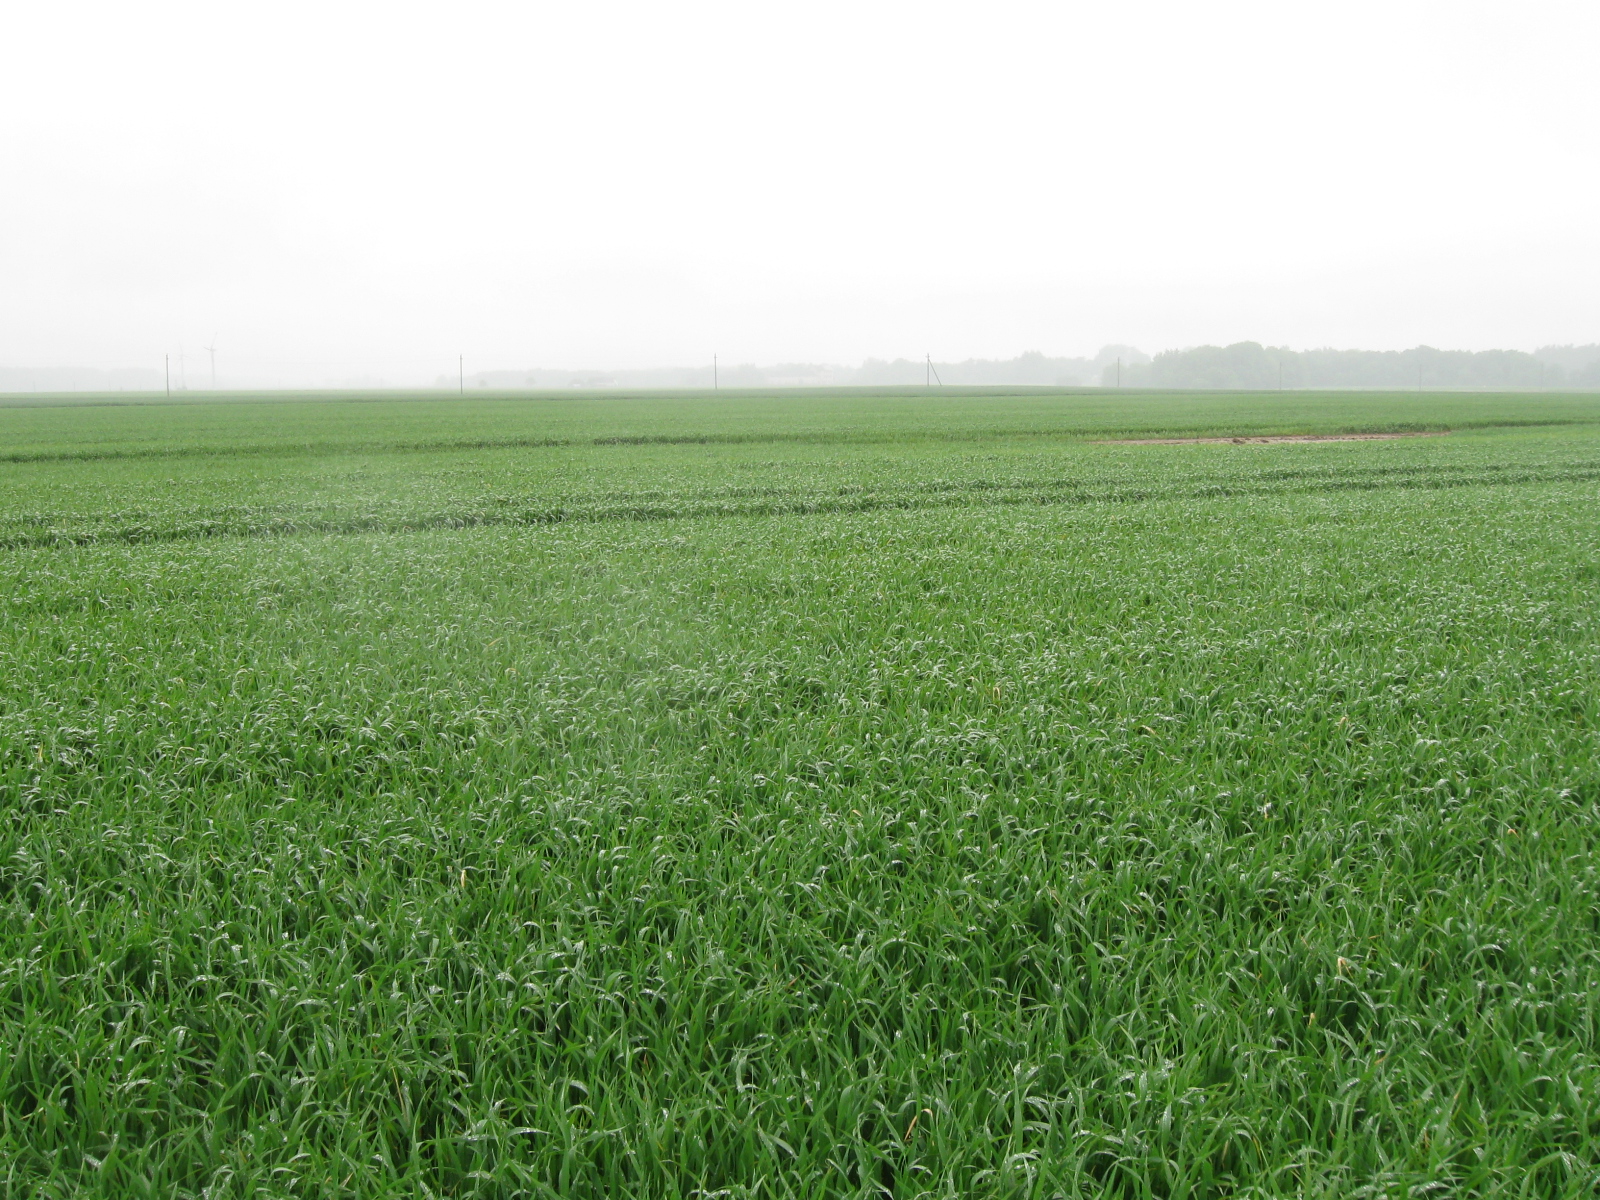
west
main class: Cropland
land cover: Common wheat
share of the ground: > 75 %
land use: Agriculture (excluding fallow land and kitchen gardens)
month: May
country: LT
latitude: 55.0405
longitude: 22.7261
